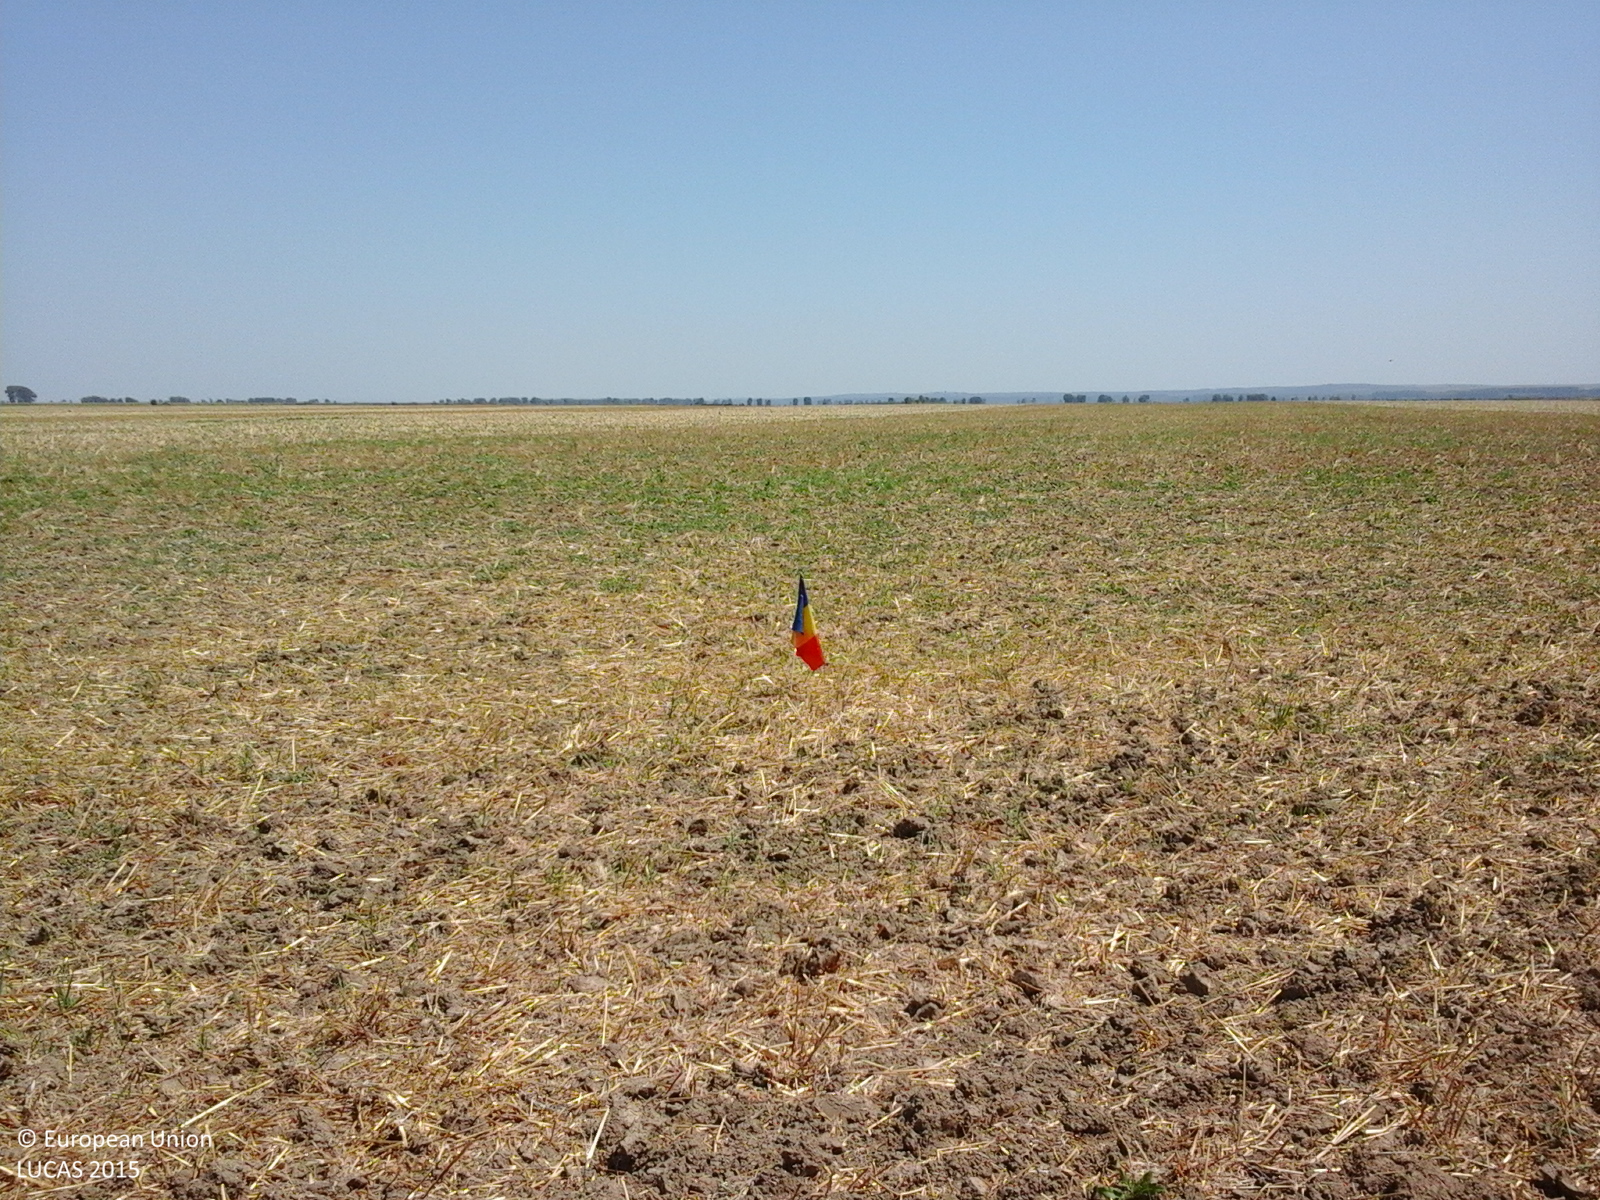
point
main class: Cropland
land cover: Durum wheat
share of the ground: < 10 %
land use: Agriculture (excluding fallow land and kitchen gardens)
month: July
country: RO
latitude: 44.2581
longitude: 27.8745
